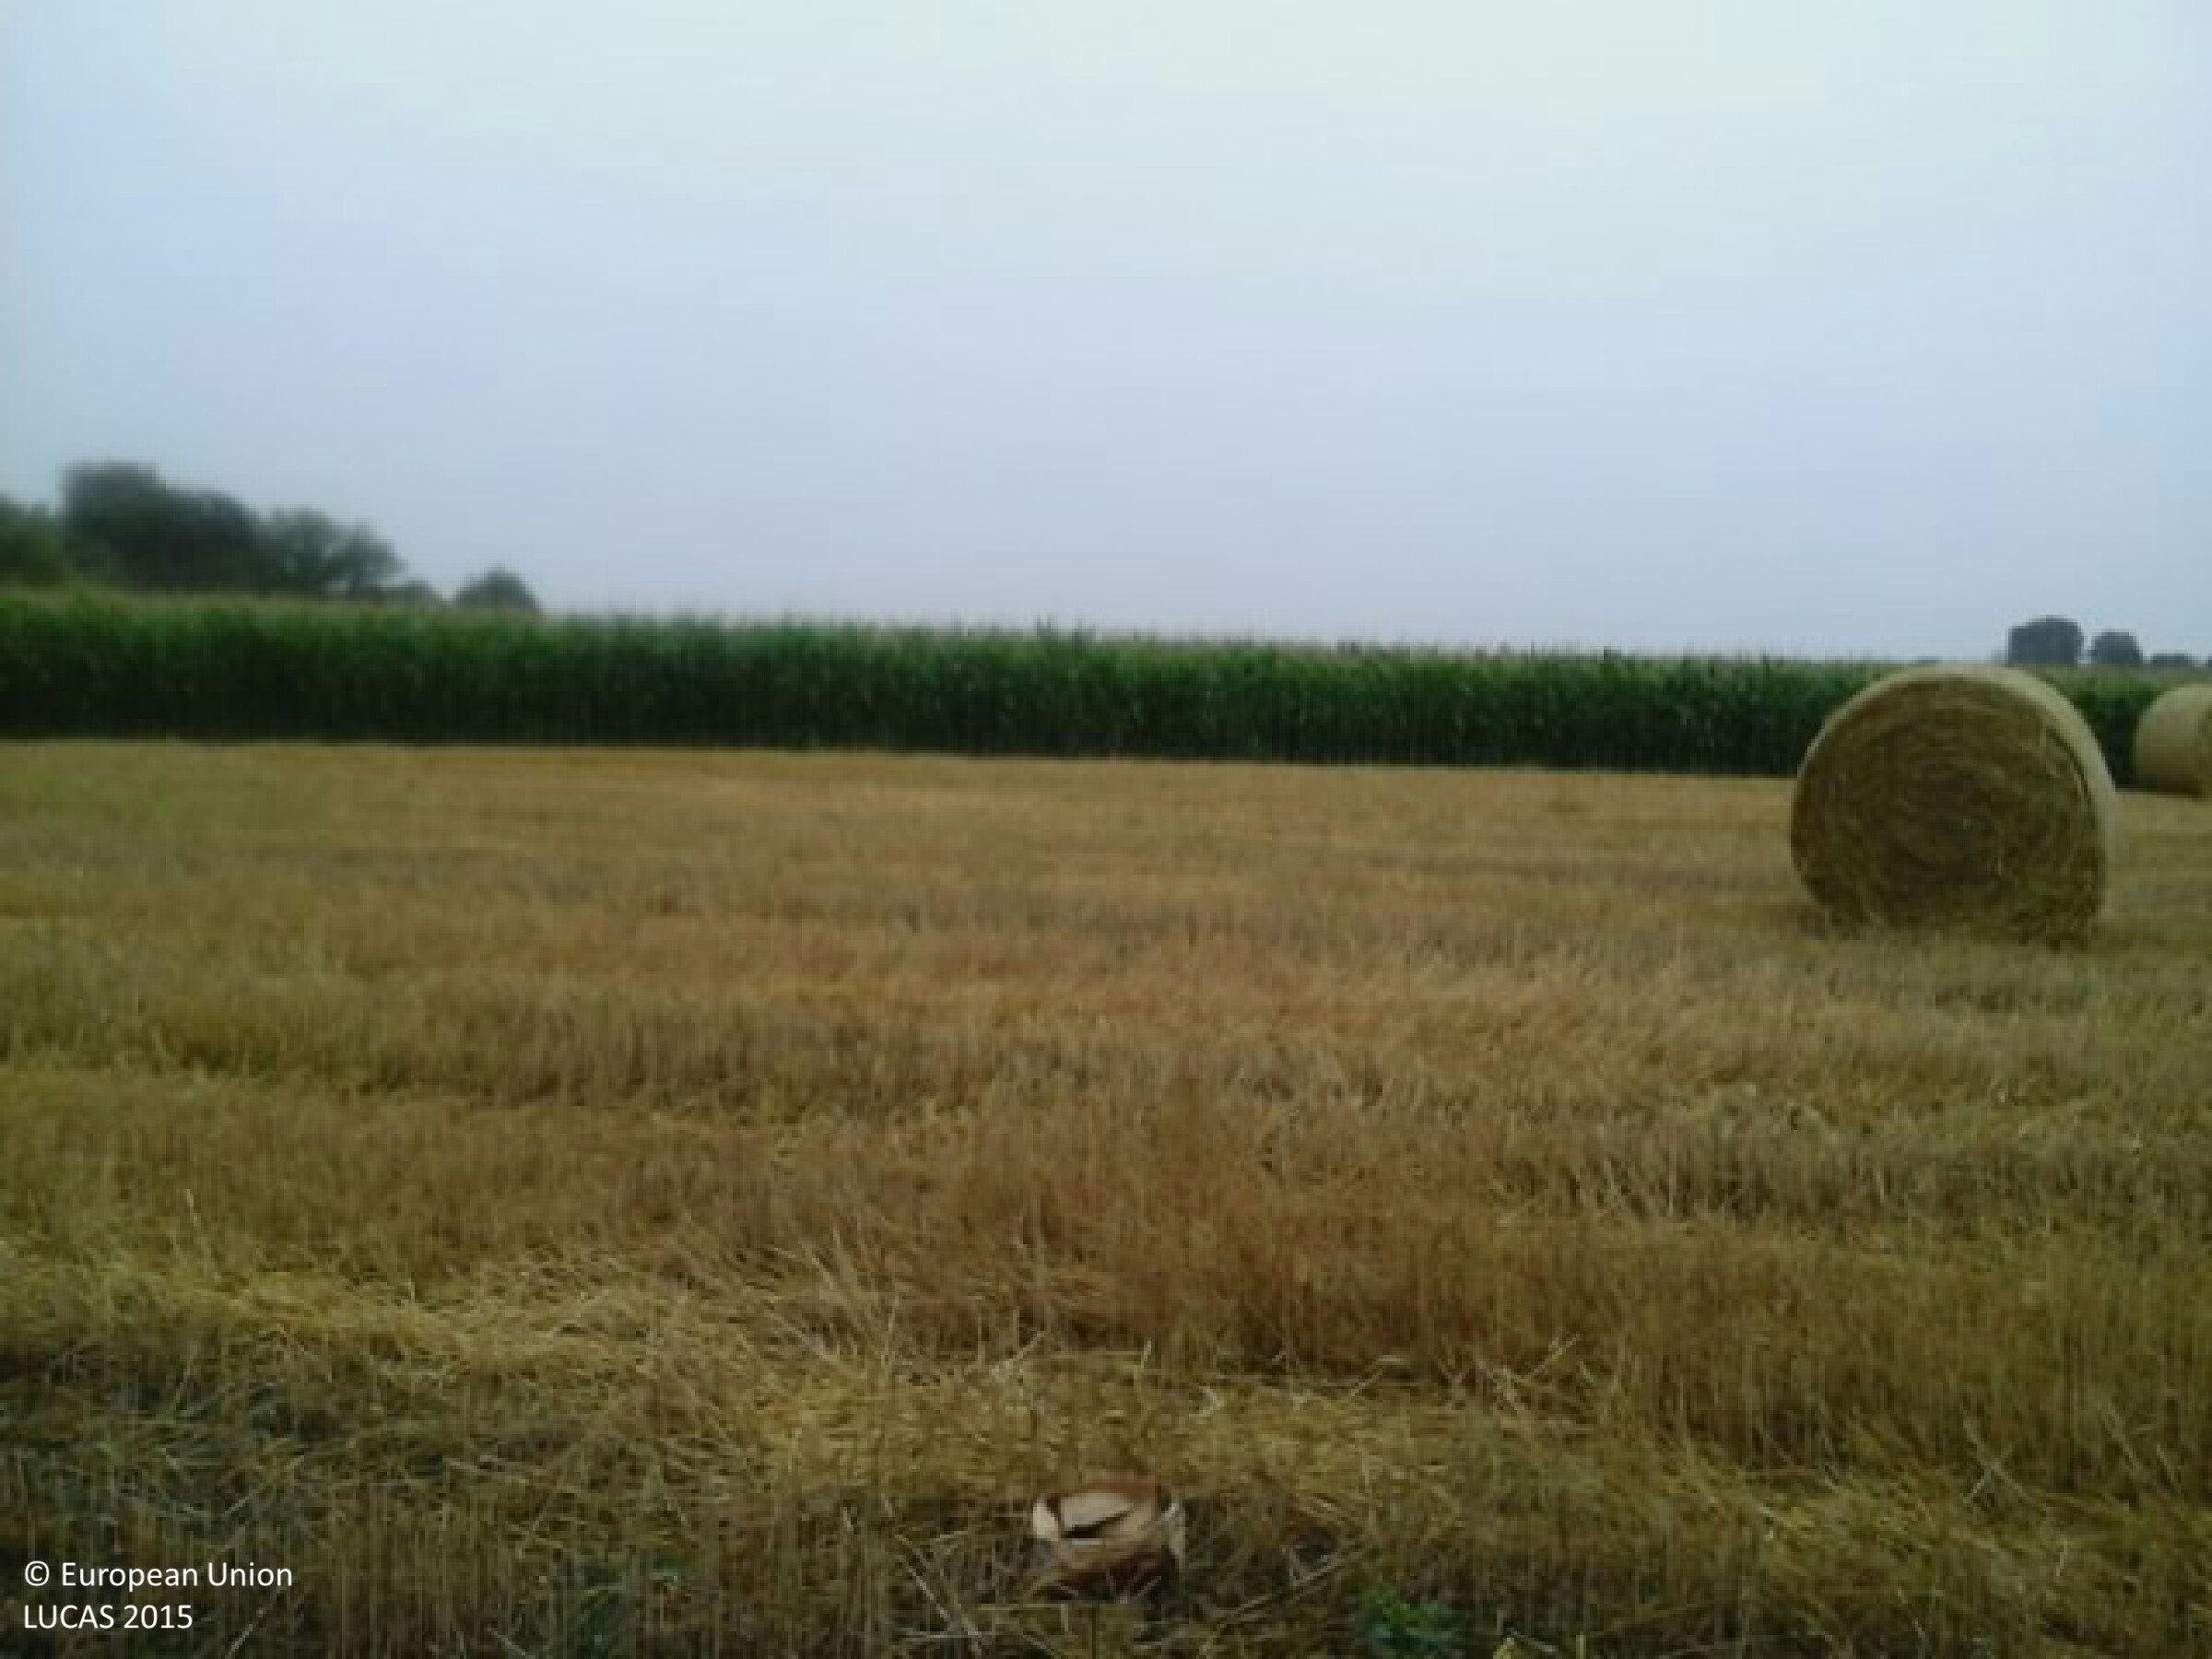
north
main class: Cropland
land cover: Rye
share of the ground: 50 - 75 %
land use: Agriculture (excluding fallow land and kitchen gardens)
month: July
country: HU
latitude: 46.3452
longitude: 18.8606
